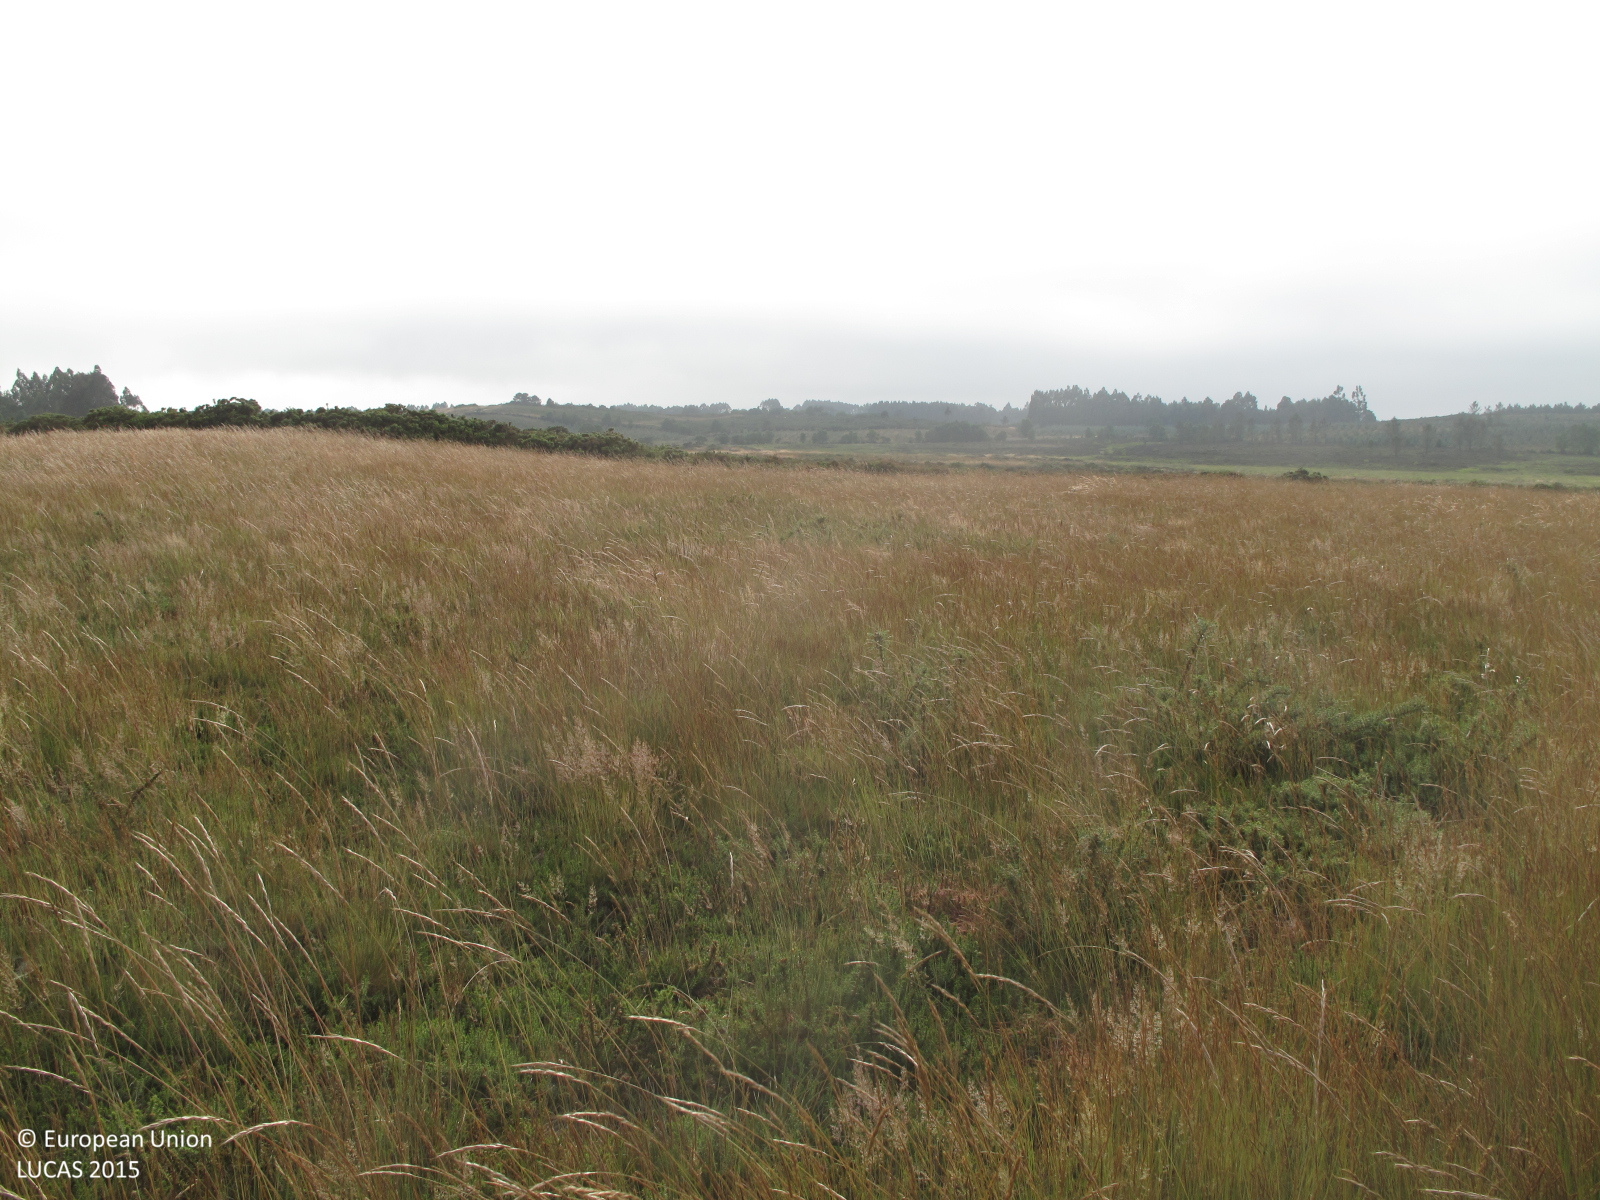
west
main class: Grassland
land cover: Grassland without tree/shrub cover
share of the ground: > 75 %
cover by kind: herbaceous plants 95 %, shrubs 5 %
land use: Semi-natural and natural areas not in use
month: June
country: ES
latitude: 43.1947
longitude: -8.0477
